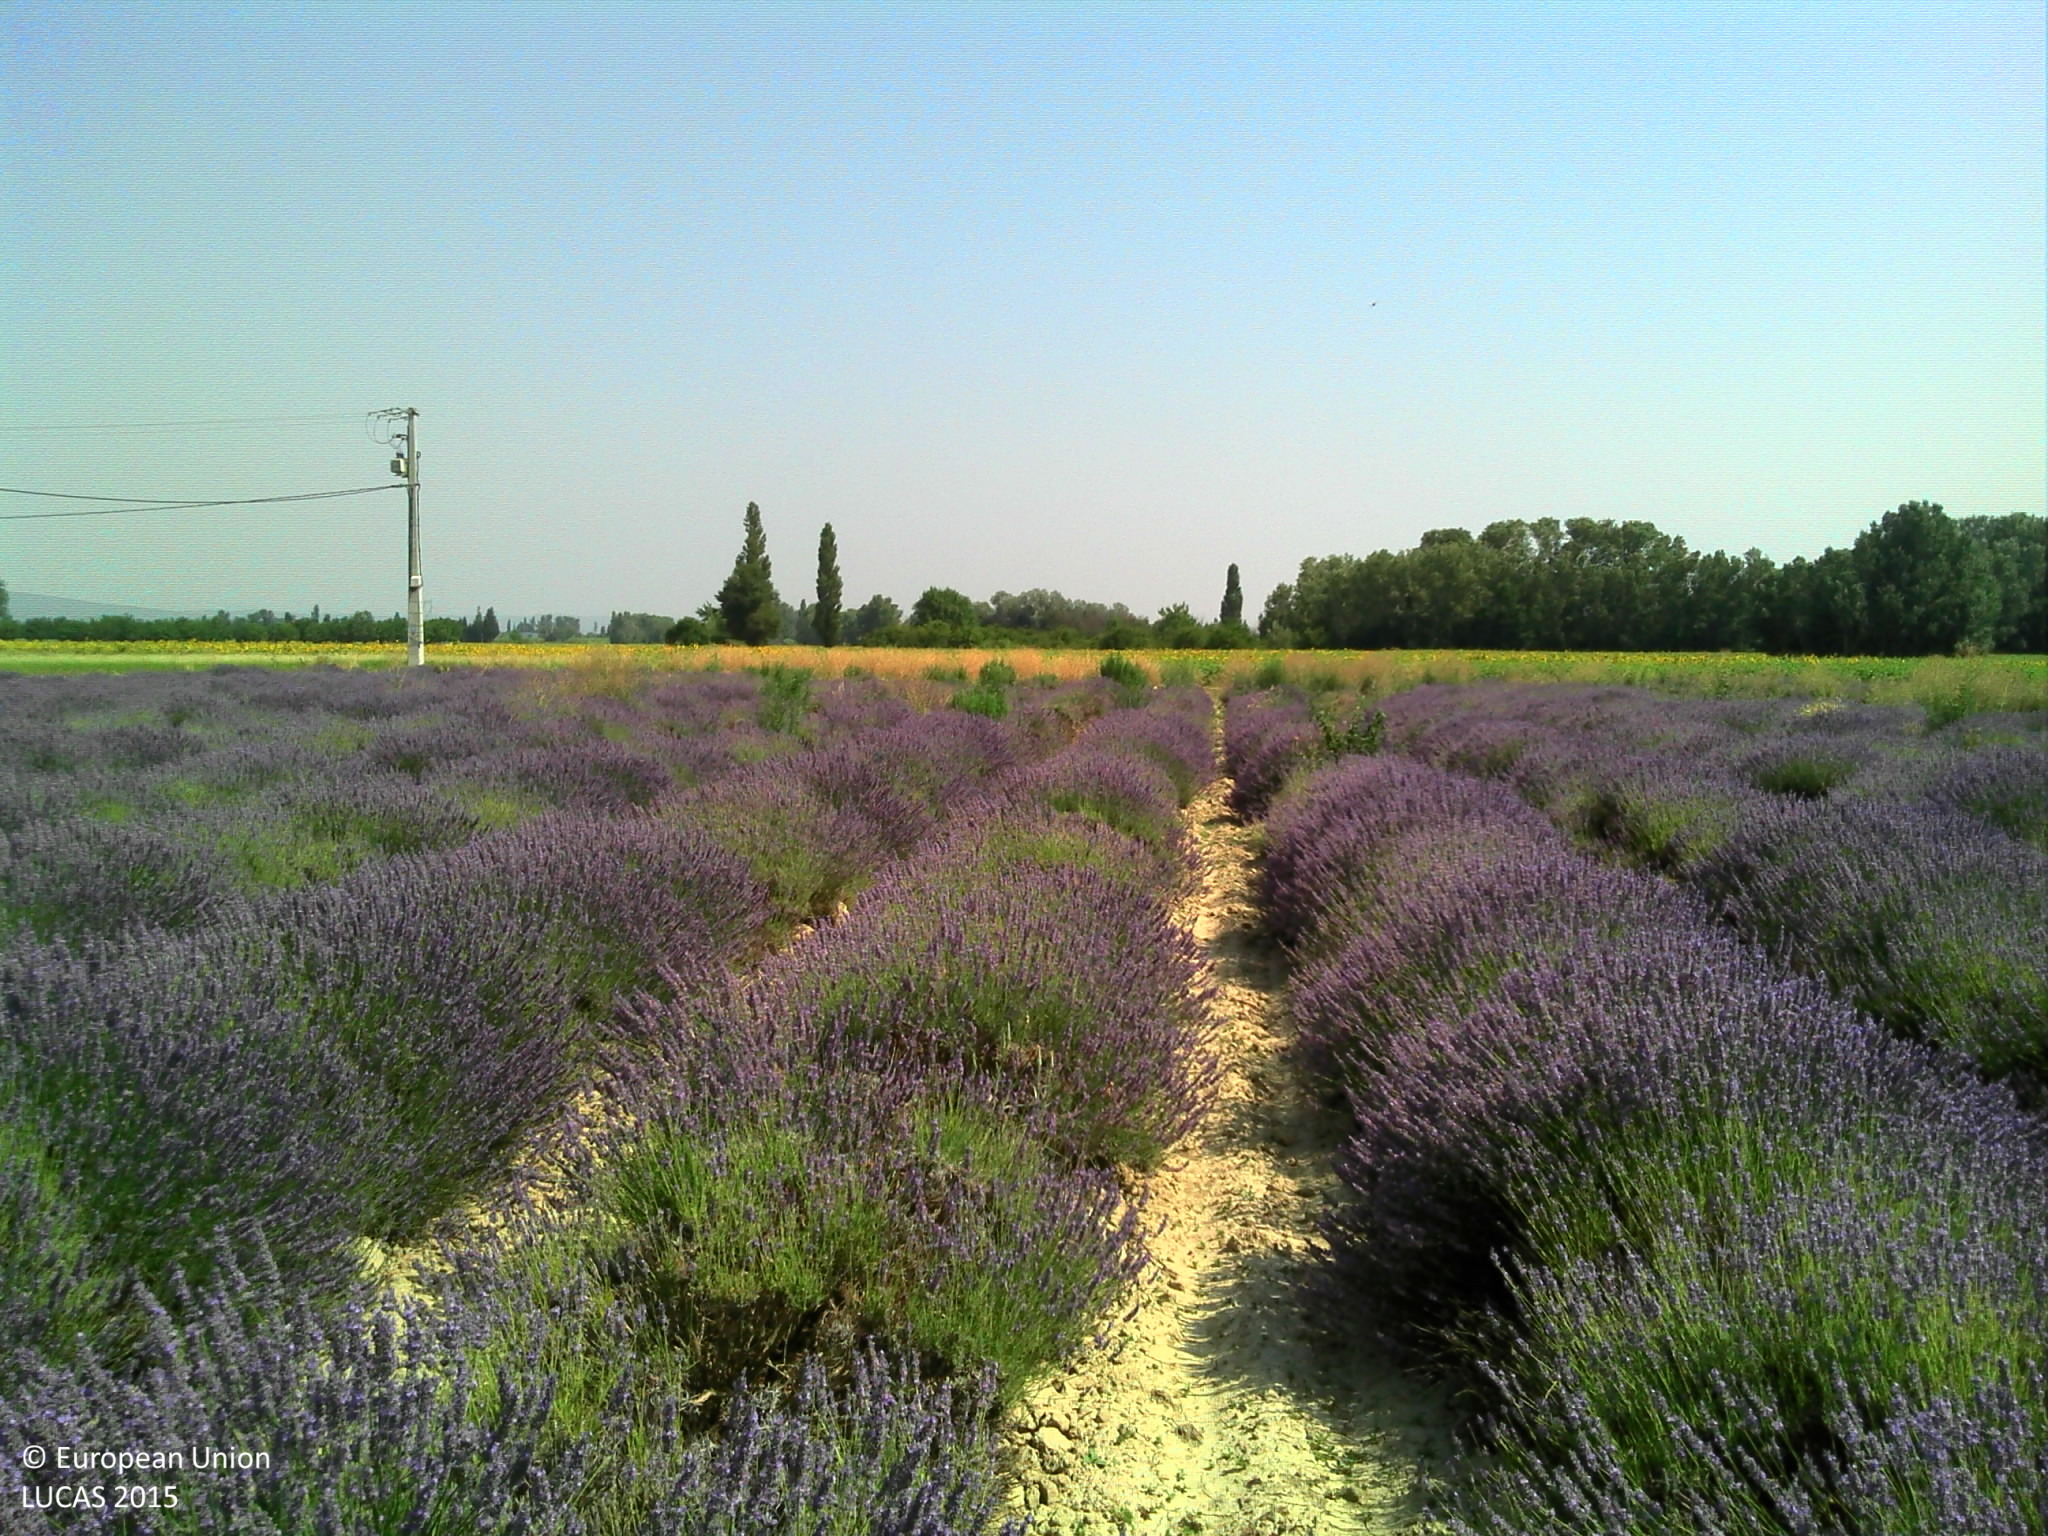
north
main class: Cropland
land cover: Permanent industrial crops
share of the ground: > 75 %
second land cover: Other bare soil
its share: > 75 %
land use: Agriculture (excluding fallow land and kitchen gardens)
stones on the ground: < 10 %
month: July
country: FR
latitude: 44.2865
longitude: 4.6817
